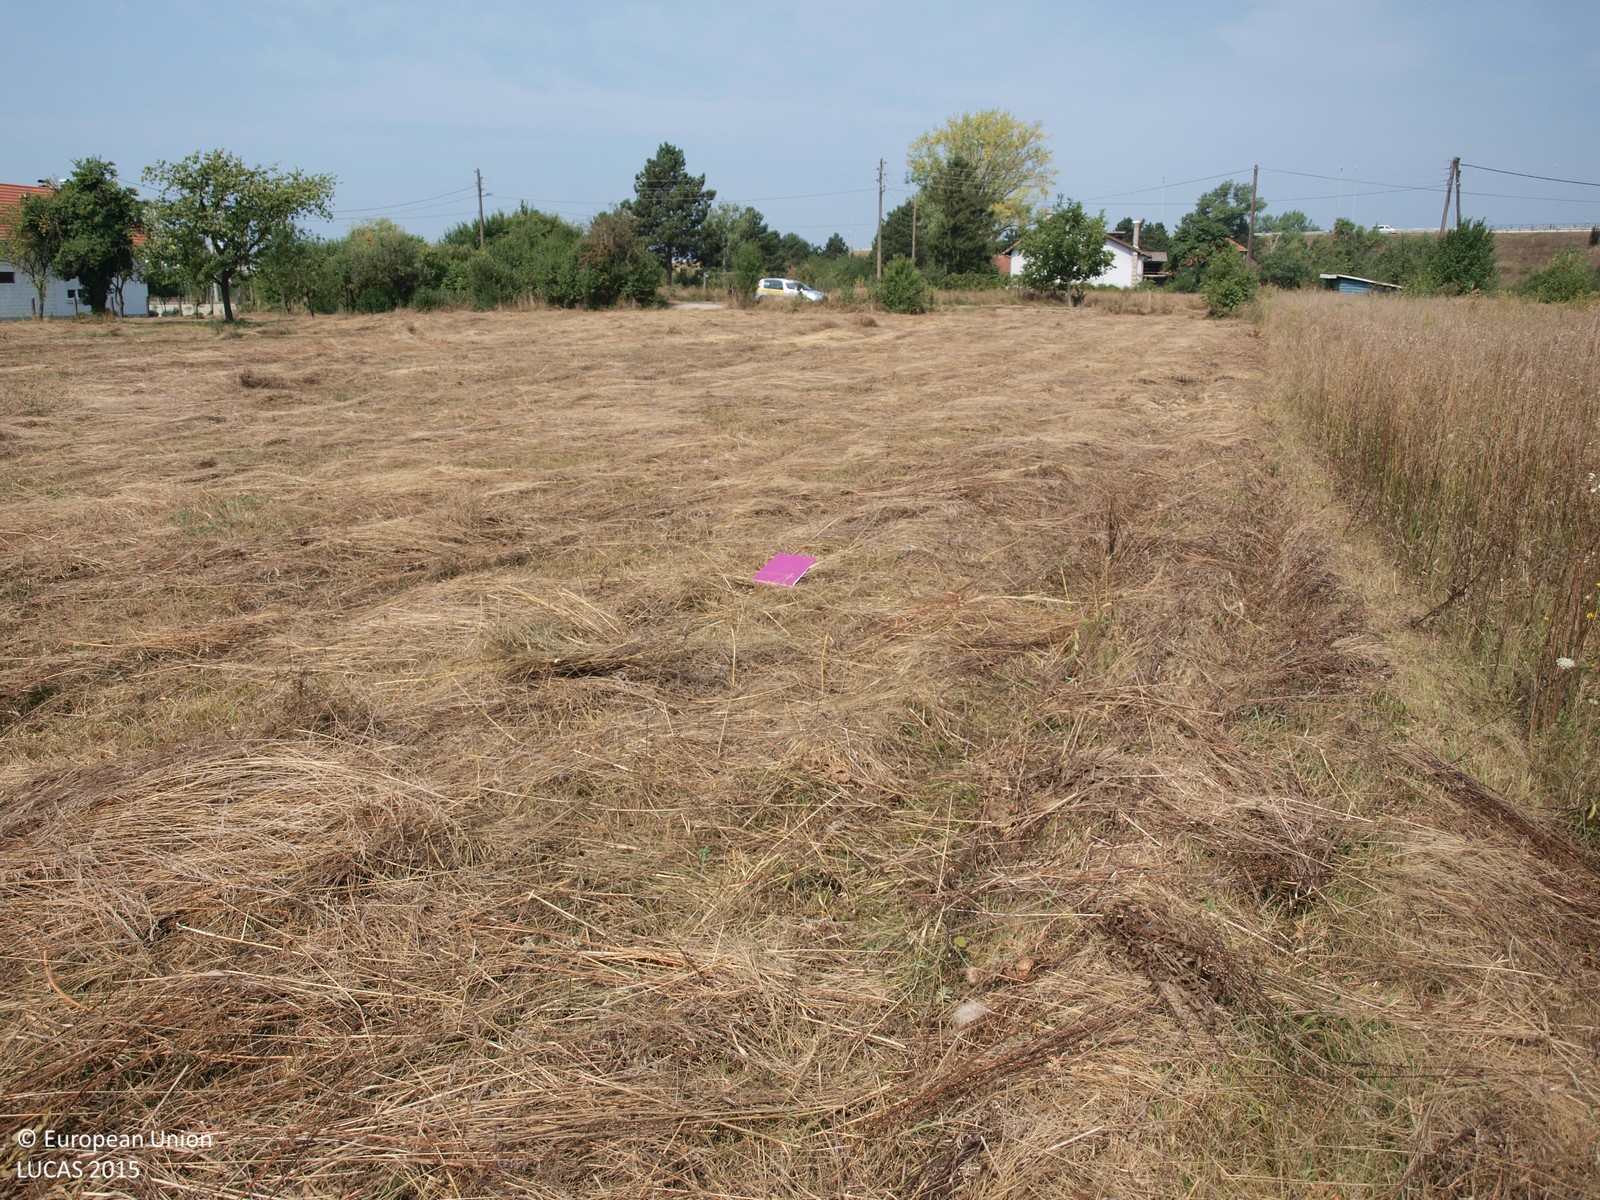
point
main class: Grassland
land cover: Grassland without tree/shrub cover
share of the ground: > 75 %
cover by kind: herbaceous plants 100 %
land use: Agriculture (excluding fallow land and kitchen gardens)
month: August
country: HR
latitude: 45.7550
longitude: 15.8984
